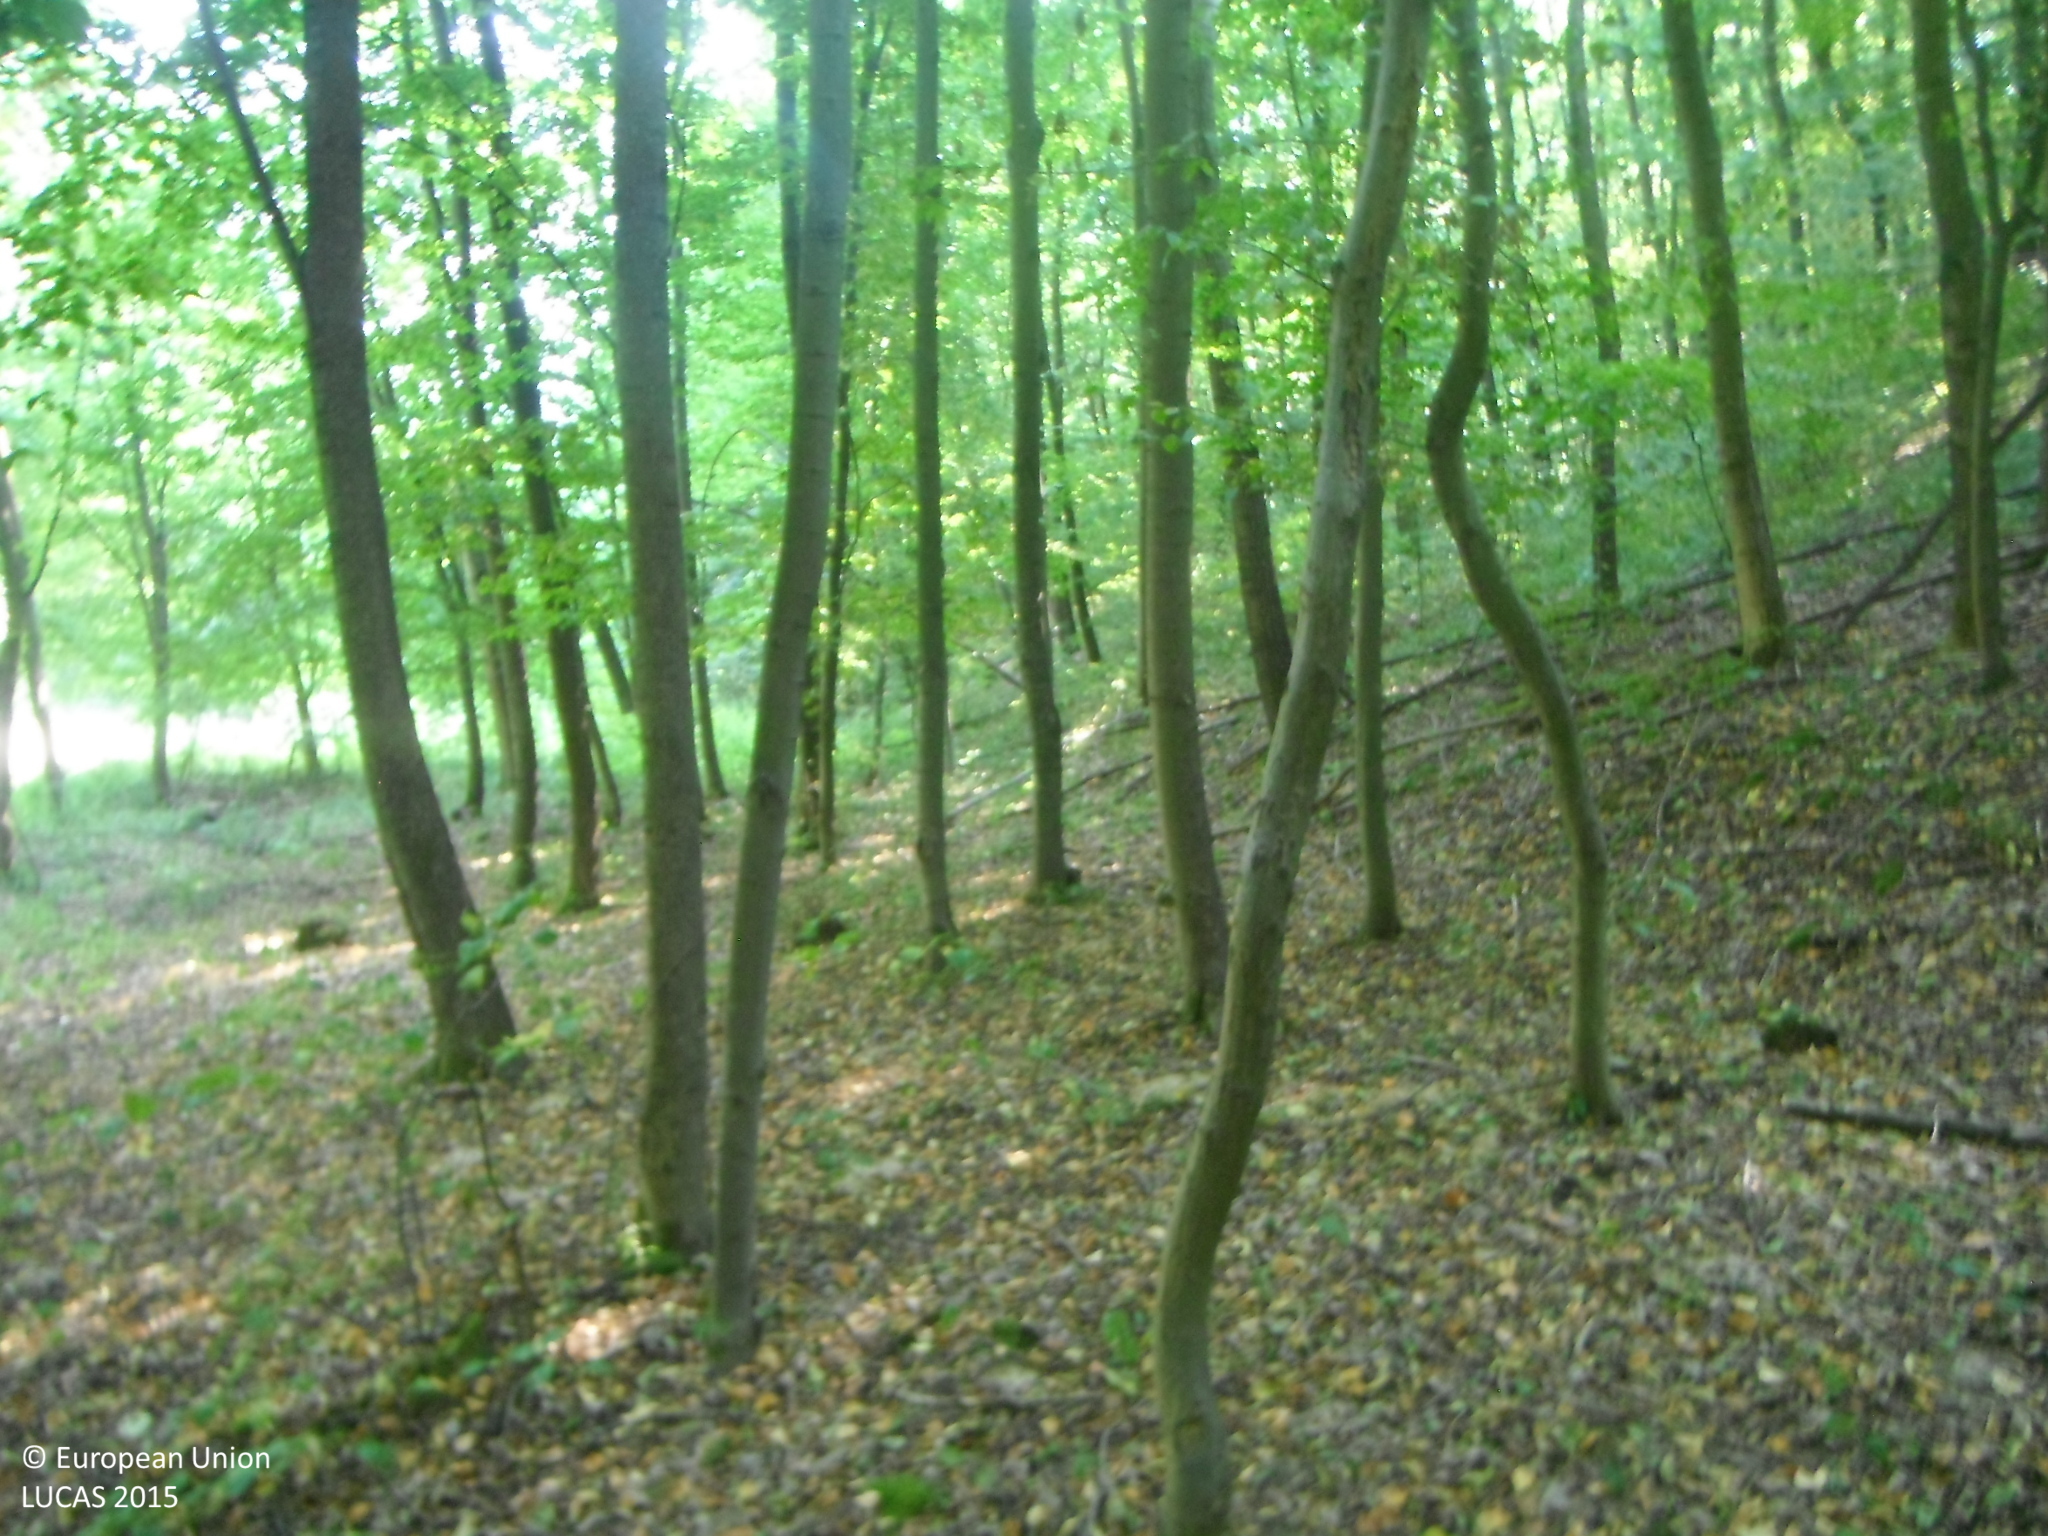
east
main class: Woodland
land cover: Broadleaved woodland
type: mesophytic deciduous forest
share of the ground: > 75 %
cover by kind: broadleaved forest trees 90 %, shrubs 5 %, unconsolidated bare surface 5 %
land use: Forestry
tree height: > 5 m
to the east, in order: Broadleaved woodland; Tracks; Broadleaved woodland; Rivers and streams; Broadleaved woodland; Grass margins; Tracks; Pine dominated mixed woodland; Broadleaved woodland
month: August
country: SK
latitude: 48.5934
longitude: 18.3546
